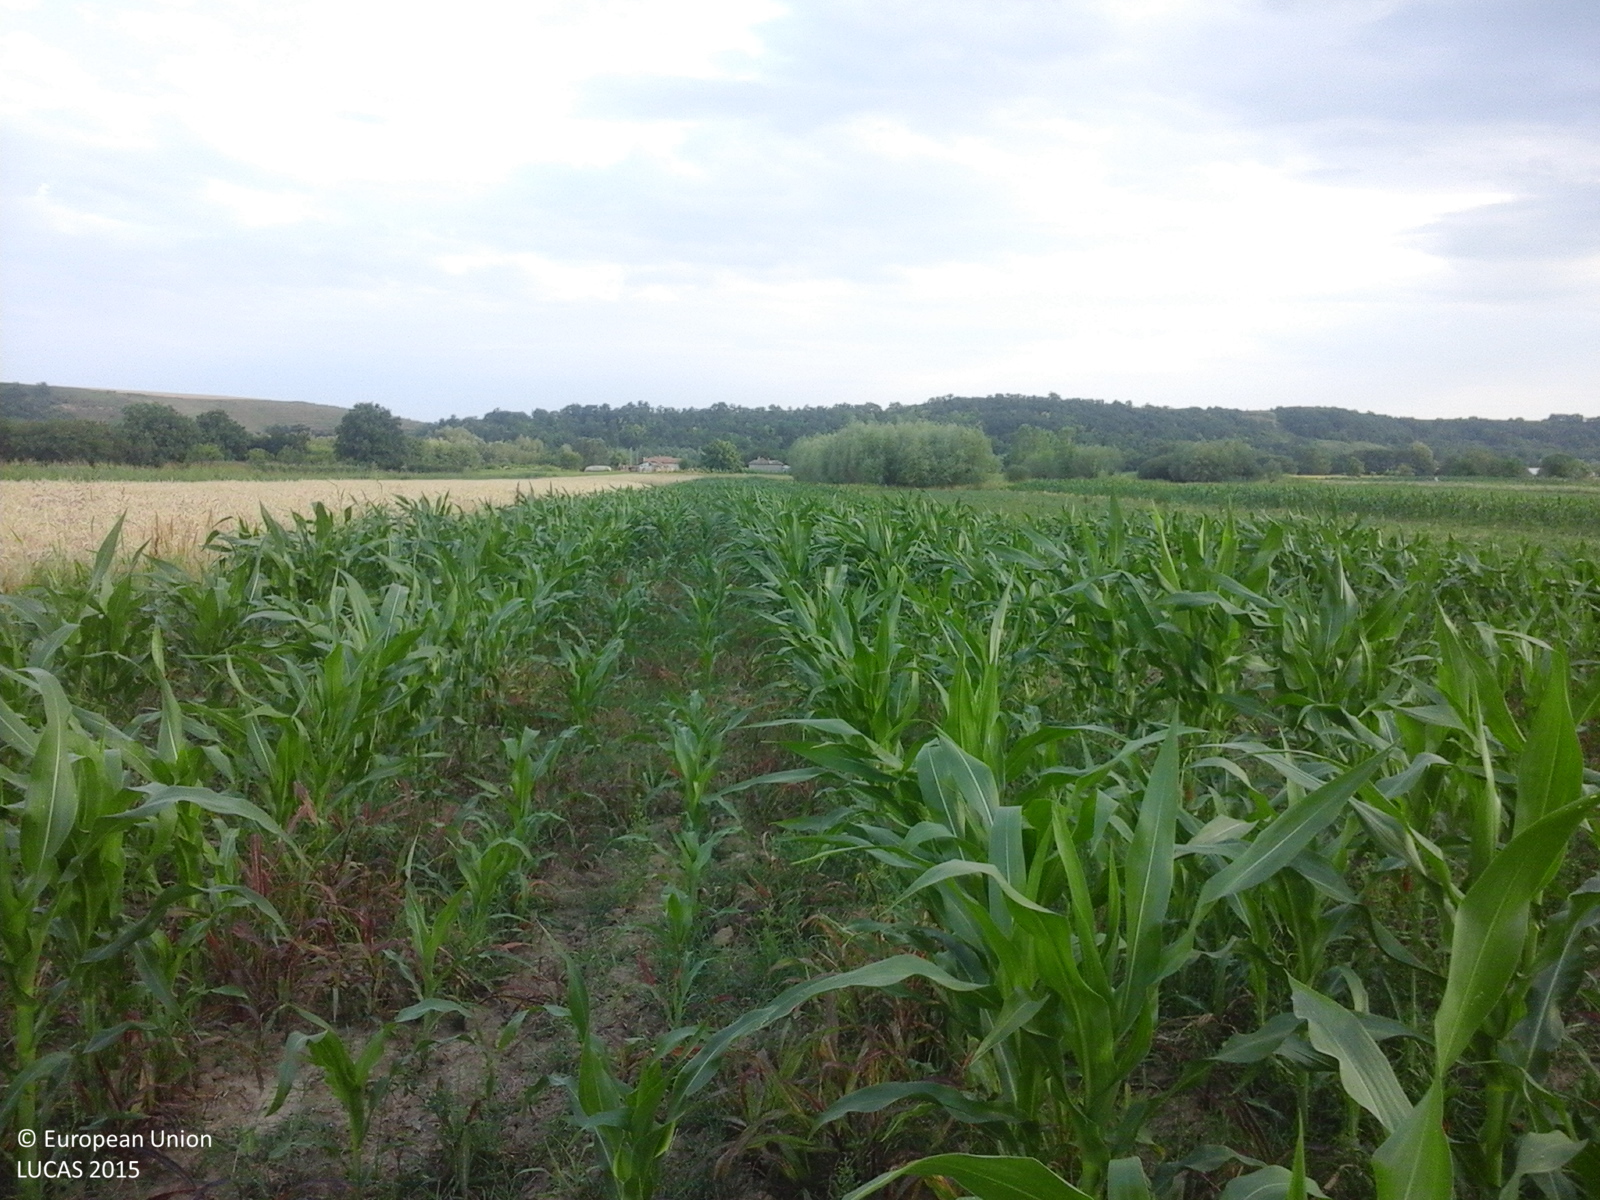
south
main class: Cropland
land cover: Maize
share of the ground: 50 - 75 %
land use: Agriculture (excluding fallow land and kitchen gardens)
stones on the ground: < 10 %
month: June
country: RO
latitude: 44.2003
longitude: 26.4662
